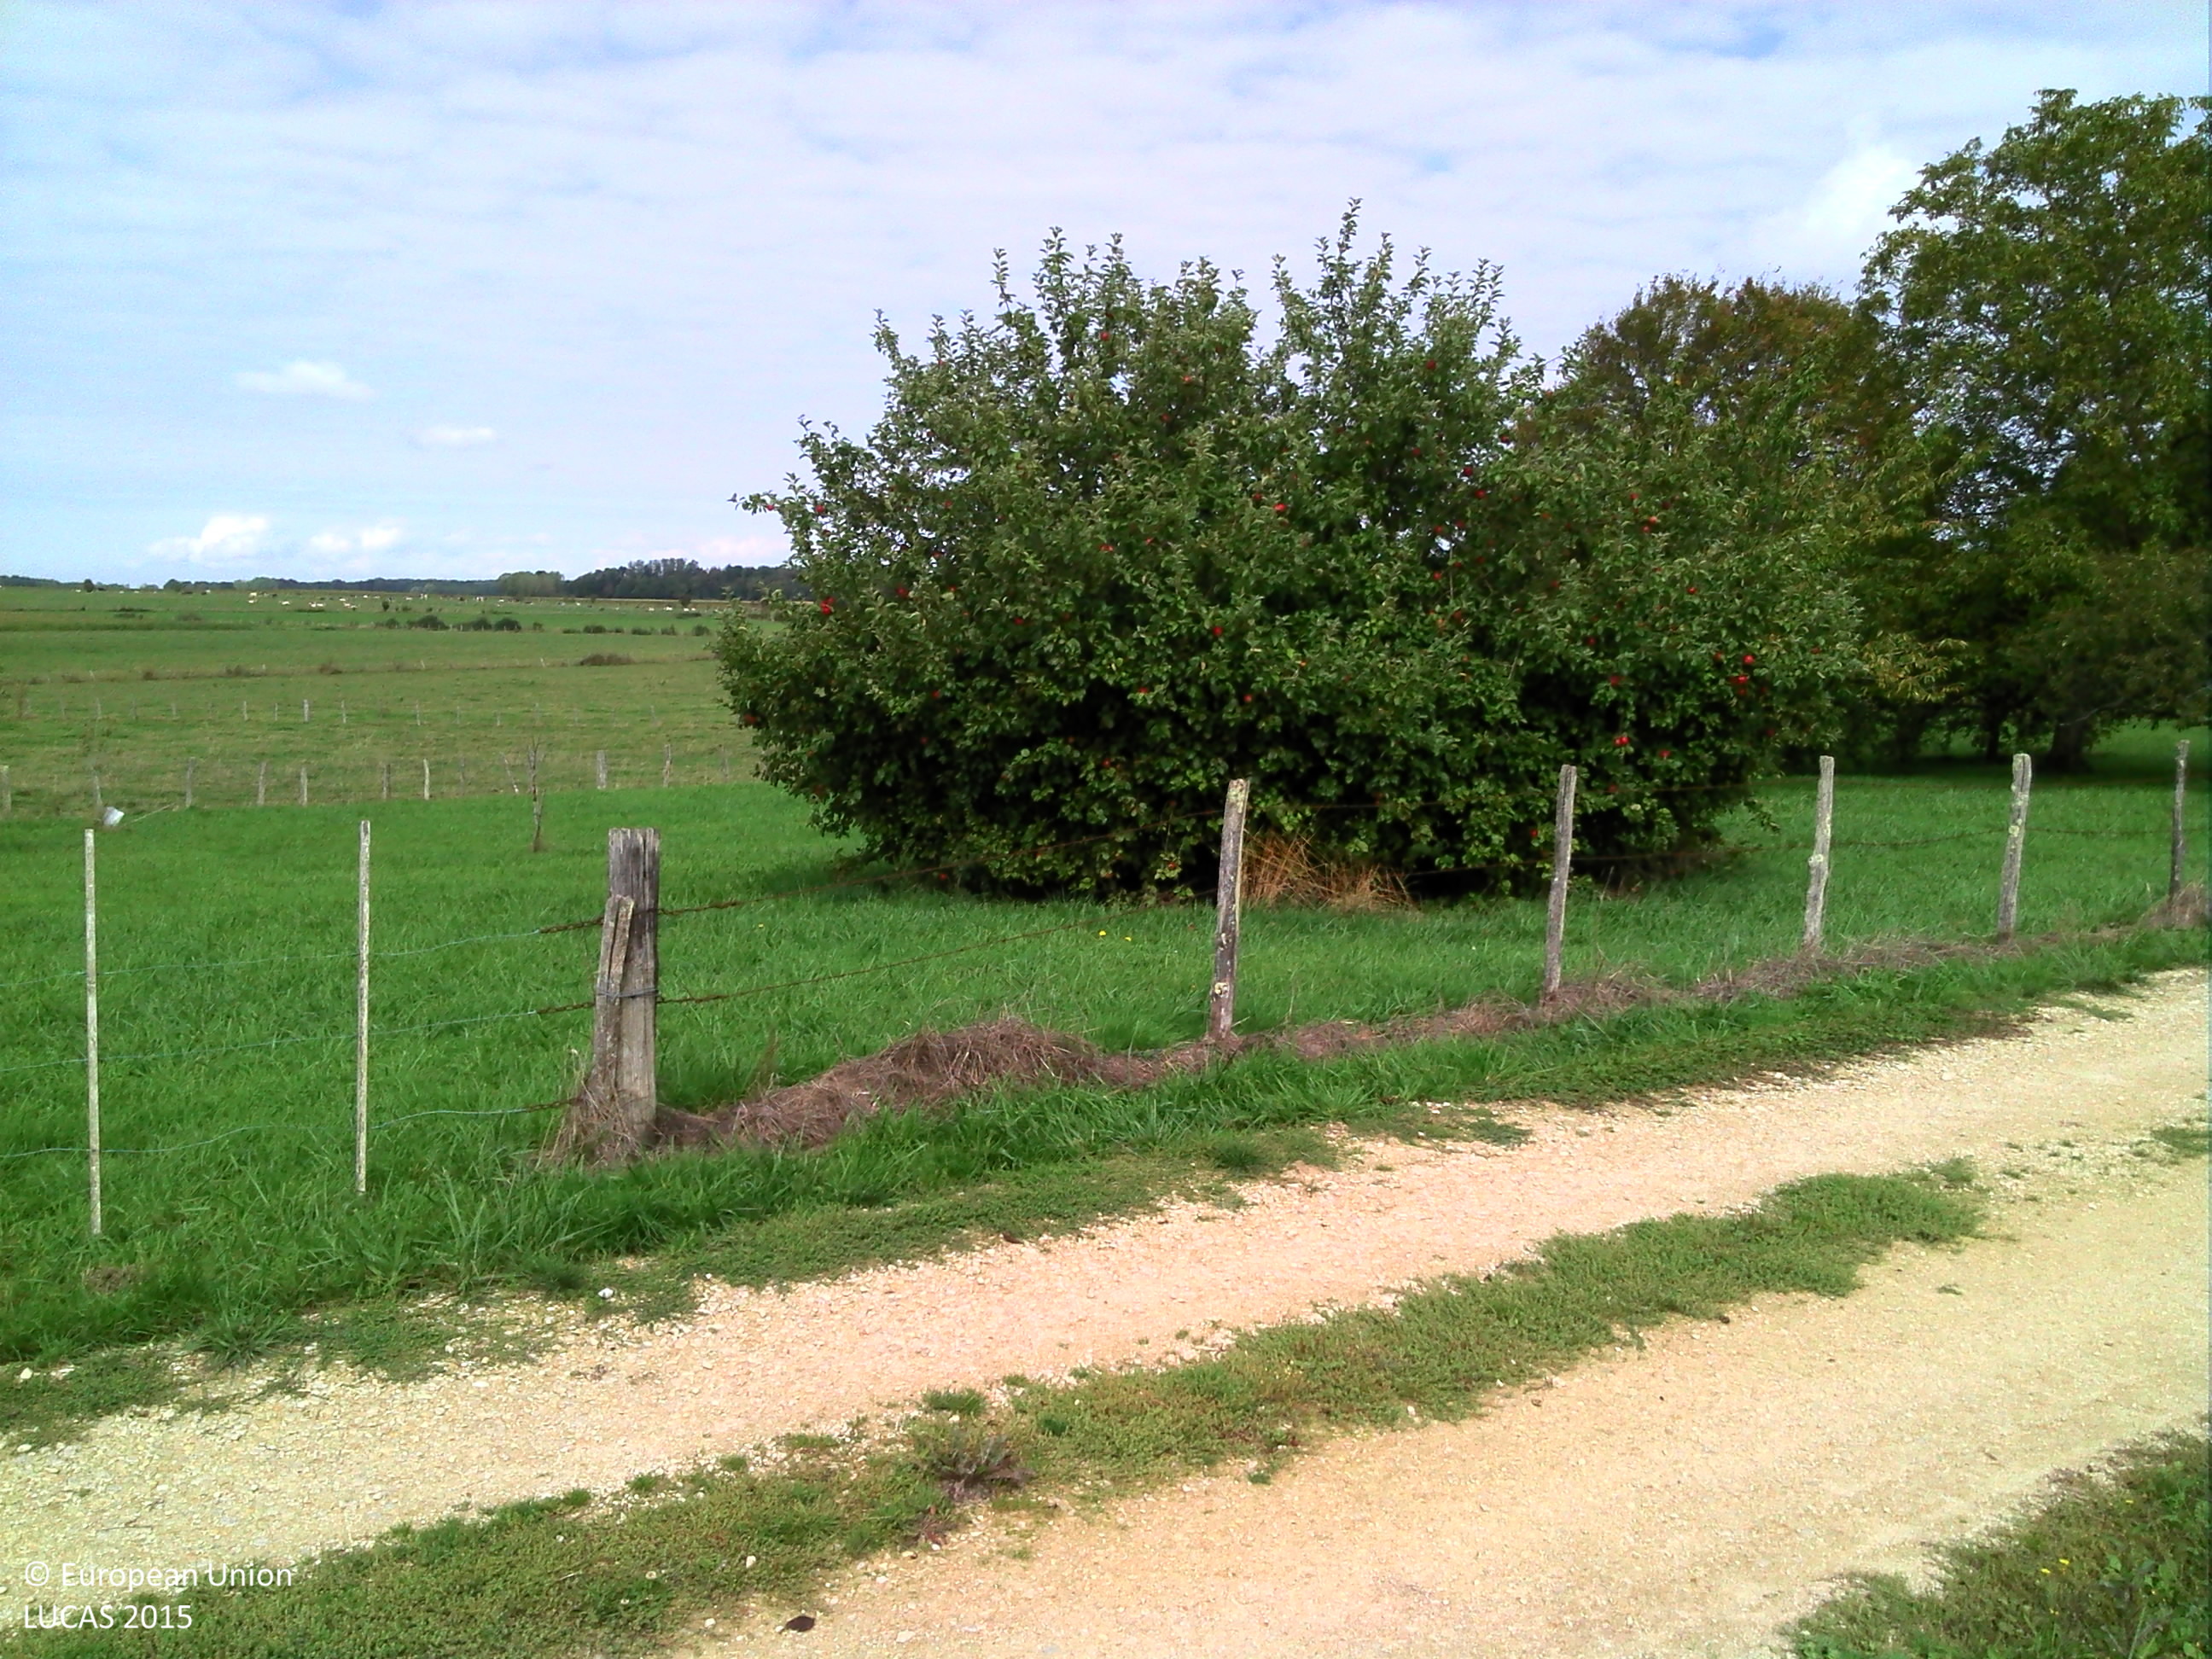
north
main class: Grassland
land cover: Grassland without tree/shrub cover
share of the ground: > 75 %
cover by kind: herbaceous plants 100 %
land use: Agriculture (excluding fallow land and kitchen gardens)
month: September
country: FR
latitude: 48.3816
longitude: 4.6373
